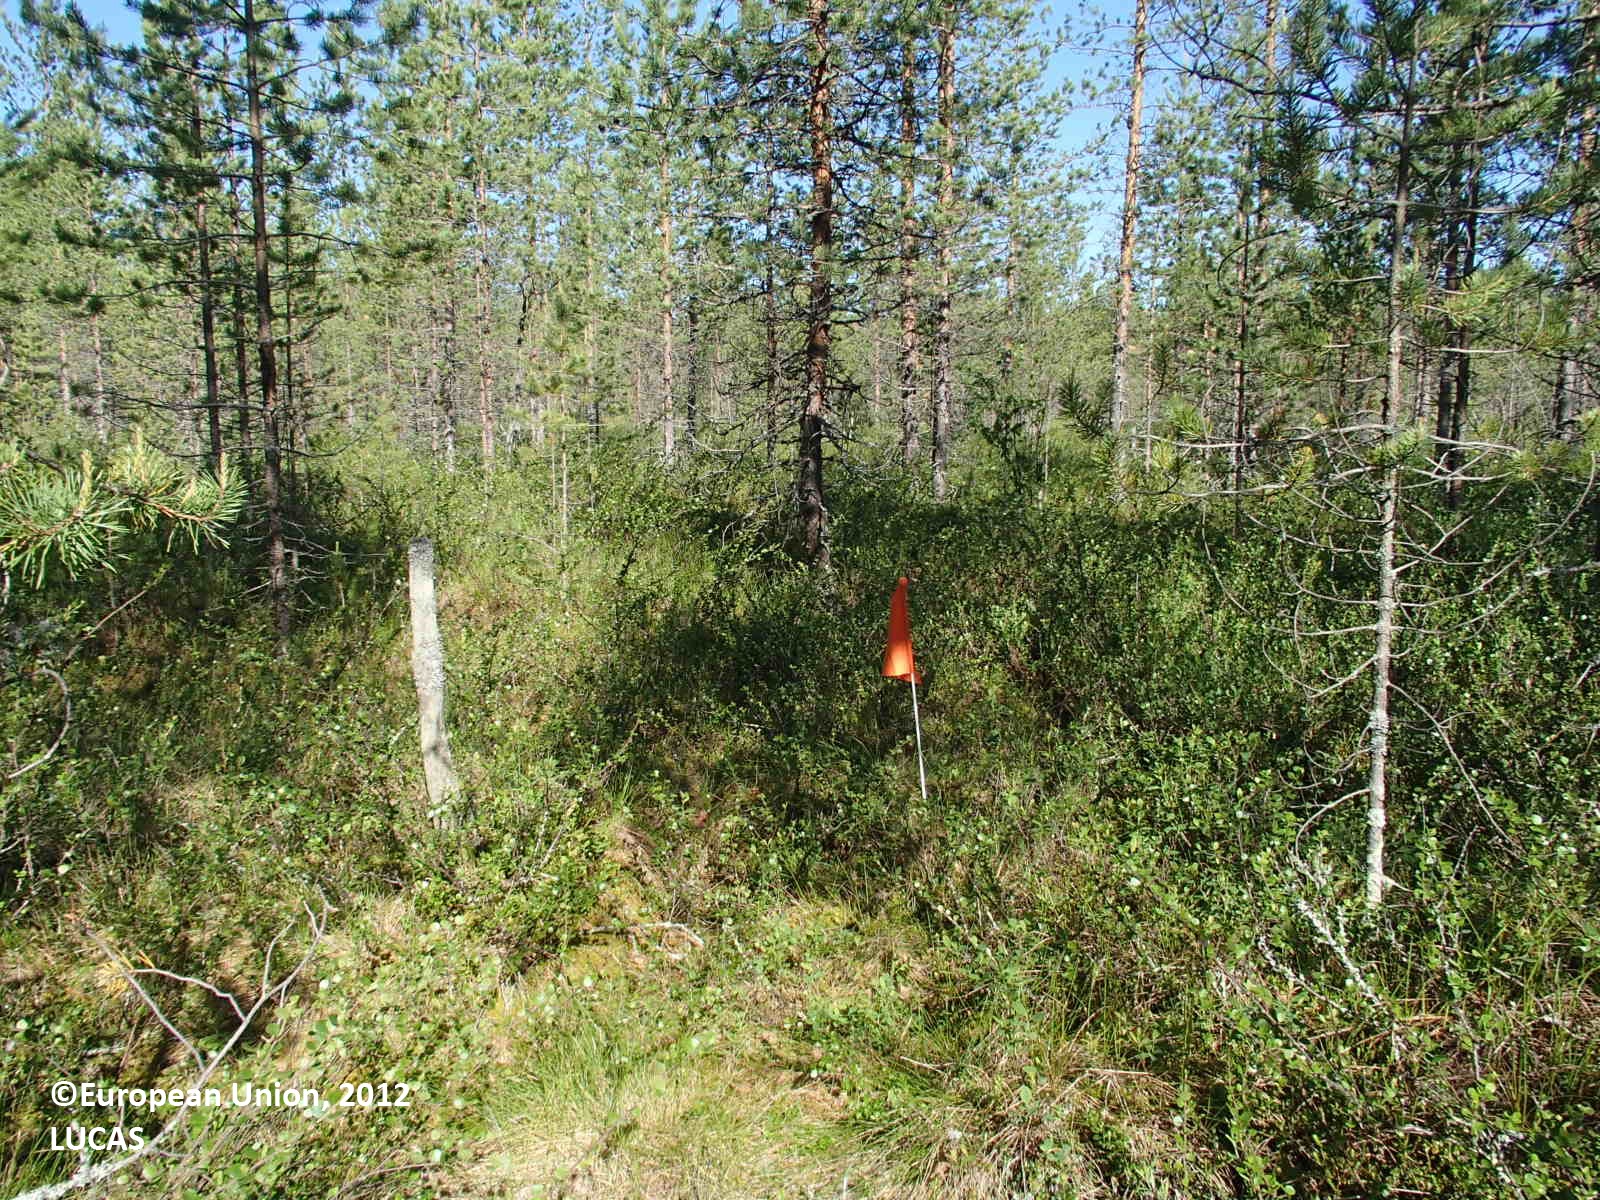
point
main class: Woodland
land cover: Pine dominated coniferous woodland
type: boreal forest
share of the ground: > 75 %
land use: Forestry
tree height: > 5 m
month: June
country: FI
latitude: 64.2072
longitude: 27.5544
